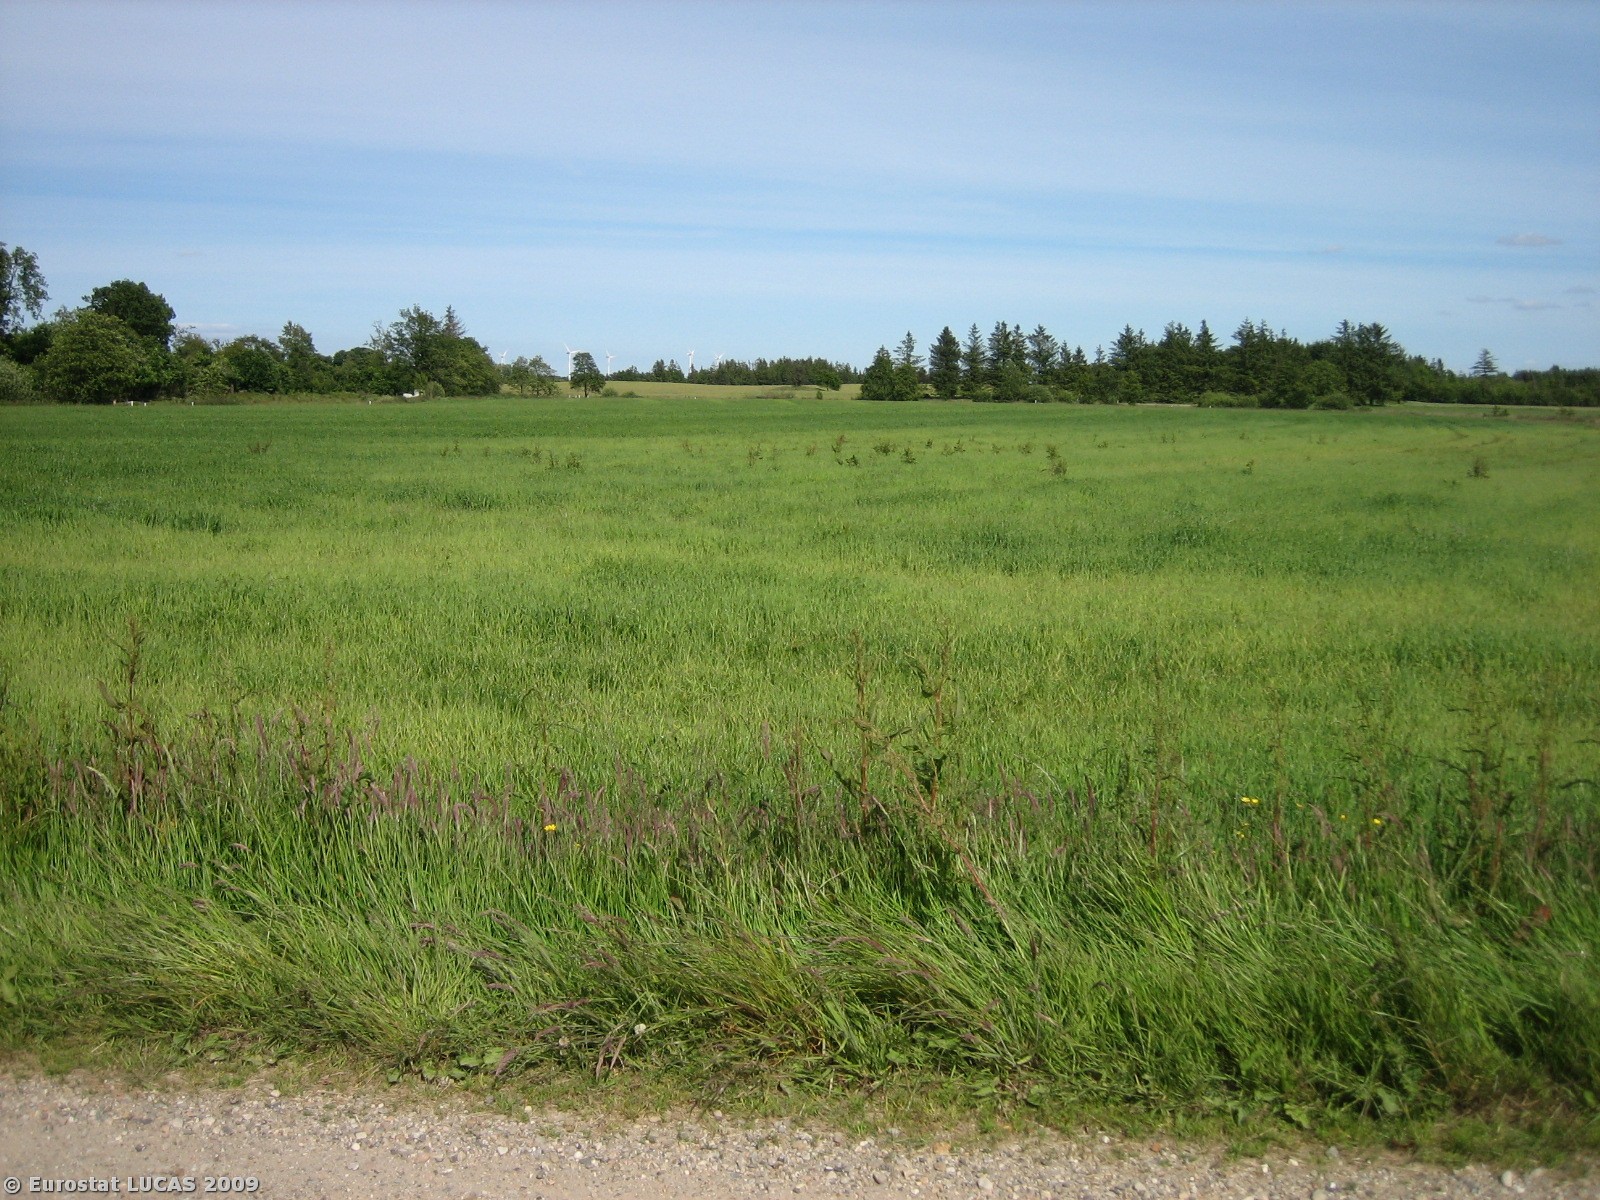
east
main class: Cropland
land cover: Common wheat
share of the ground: > 75 %
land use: Agriculture (excluding fallow land and kitchen gardens)
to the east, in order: Common wheat; Fences; Grassland without tree/shrub cover; Fences; Grassland without tree/shrub cover; Fences; Broadleaved woodland; Grassland without tree/shrub cover; Artificial constructions in urban areas; Tracks; Grass margins; Barley
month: June
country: DK
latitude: 55.7545
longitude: 9.3156
